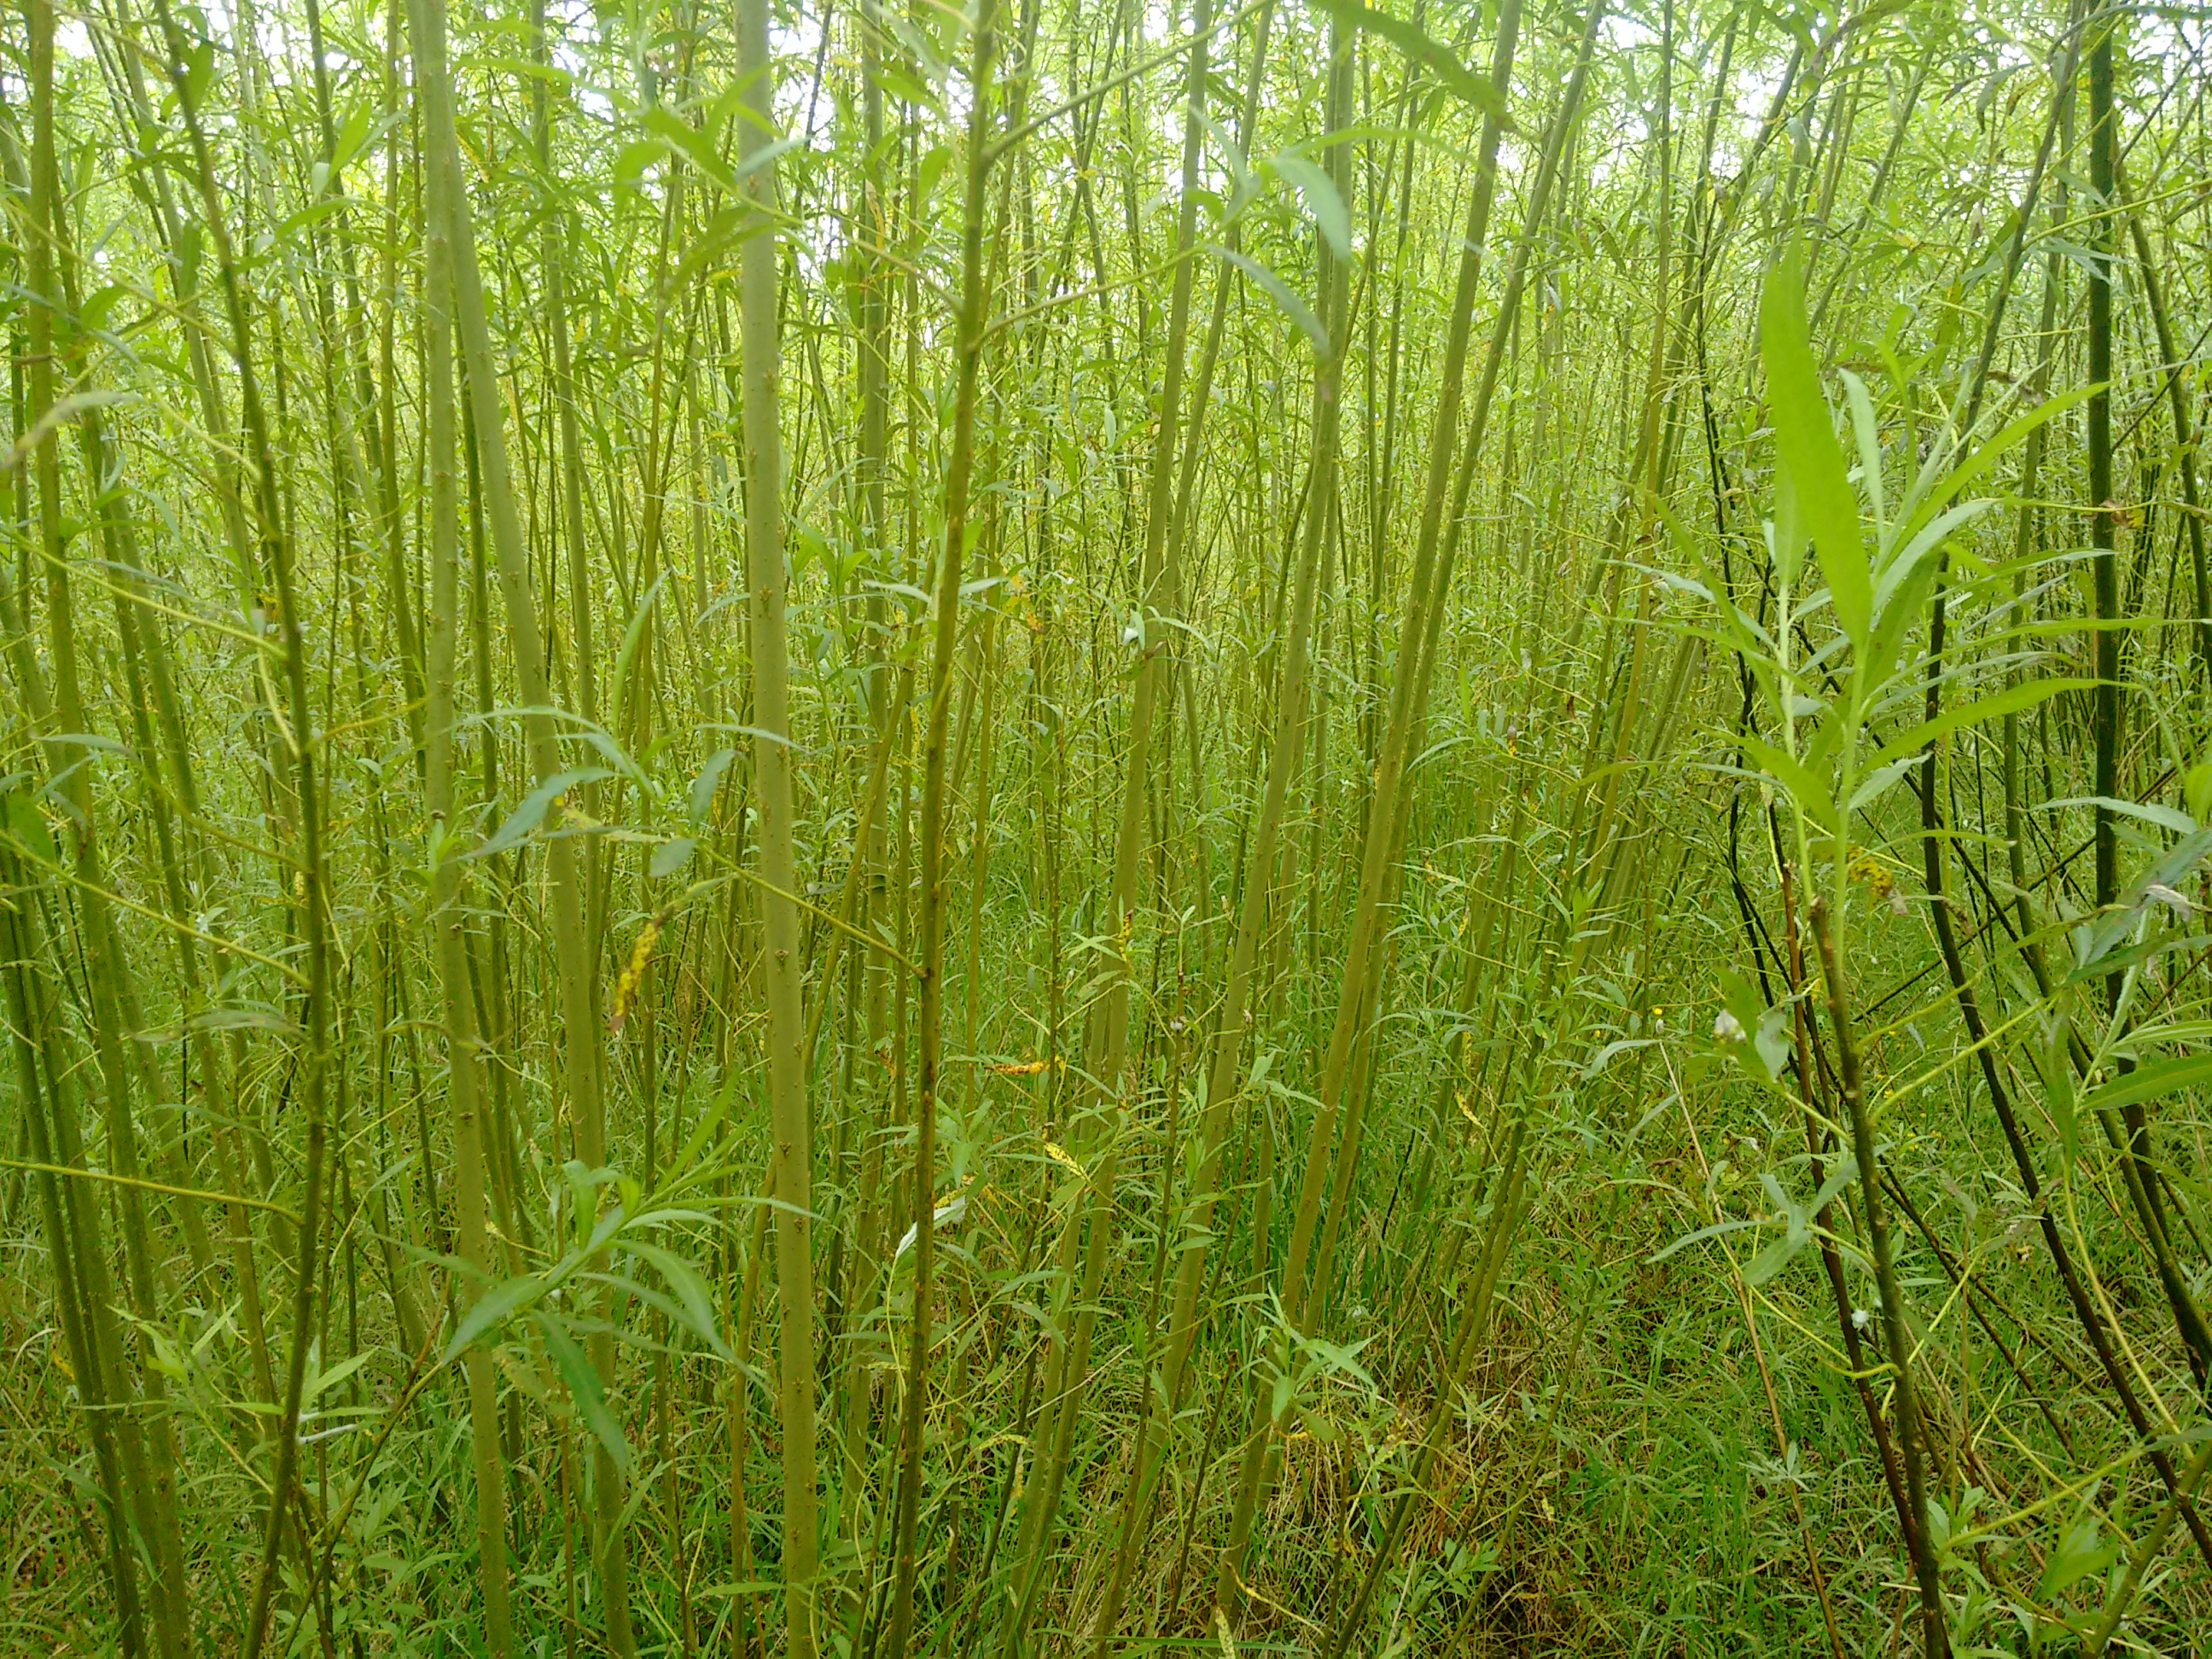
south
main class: Cropland
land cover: Permanent industrial crops
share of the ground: > 75 %
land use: Agriculture (excluding fallow land and kitchen gardens)
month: June
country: IE
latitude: 53.3810
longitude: -7.6469
